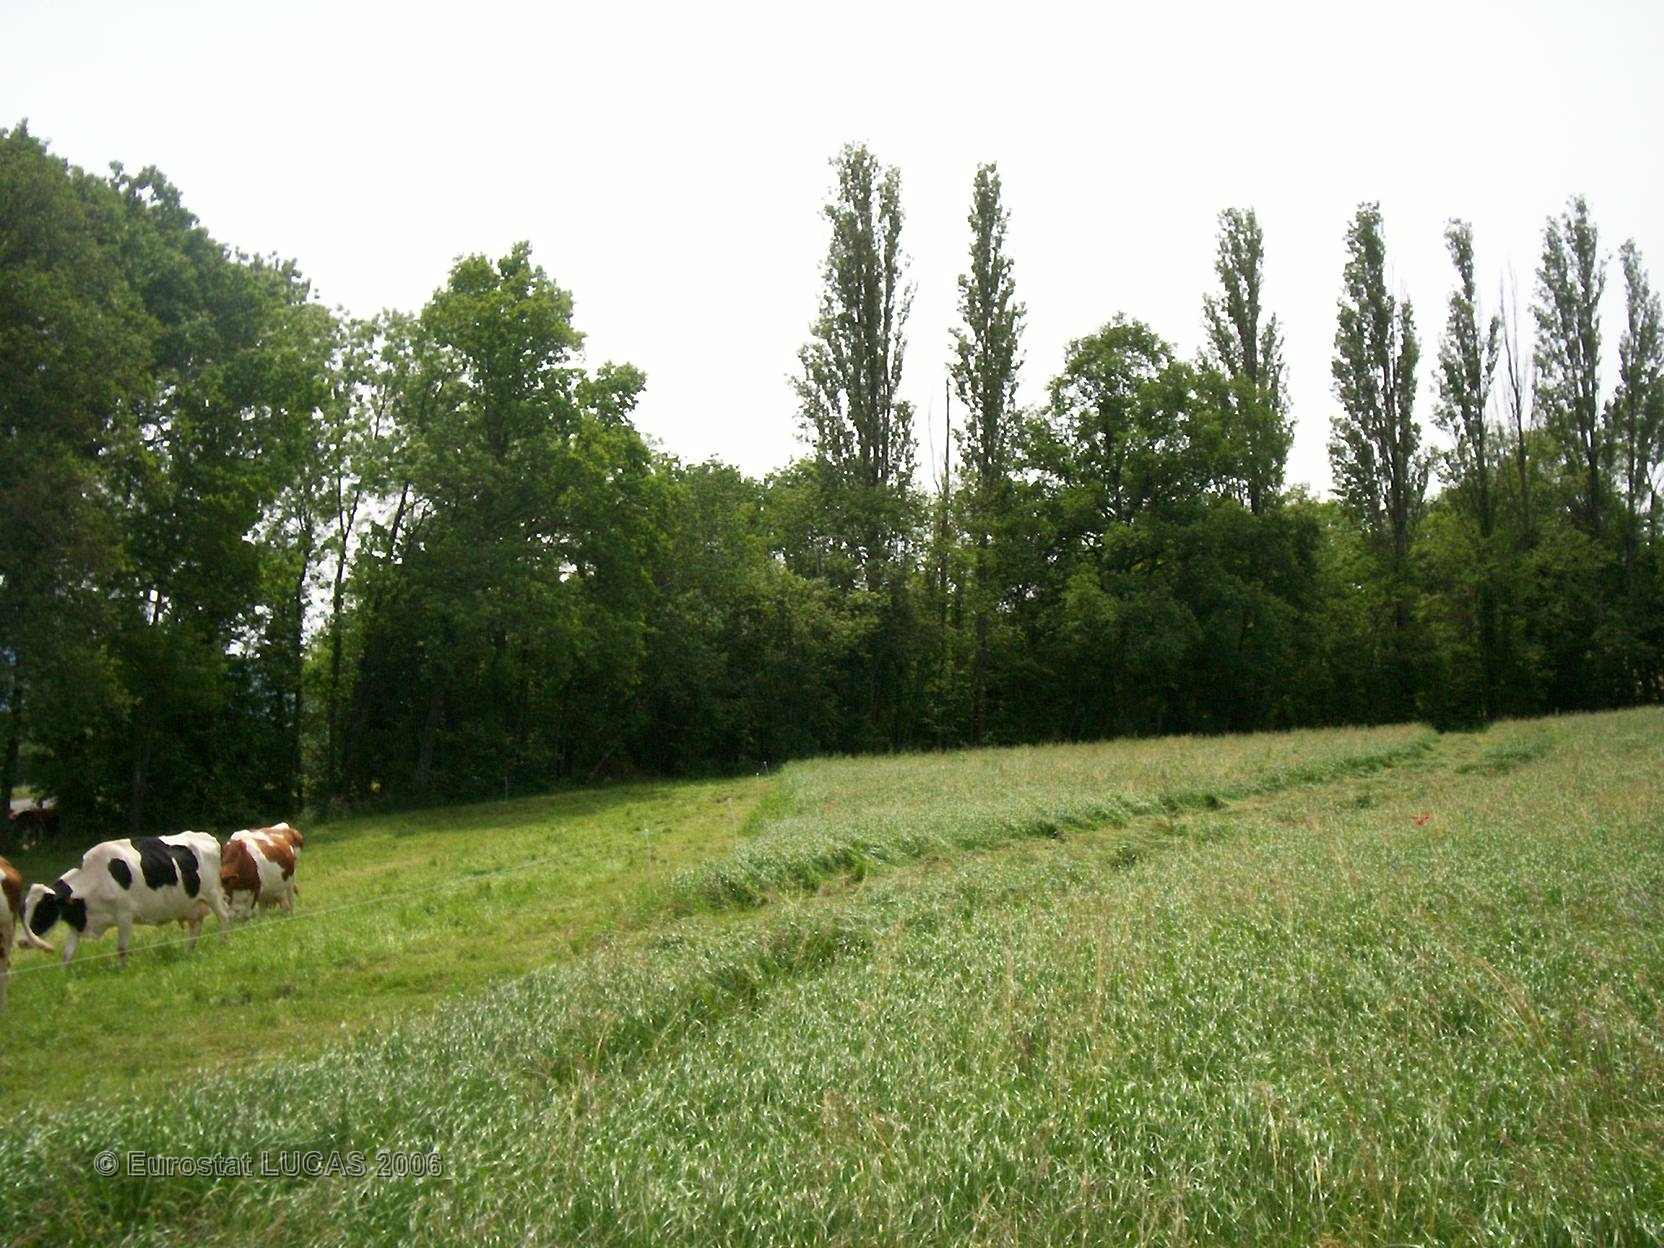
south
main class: Grassland
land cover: Grassland without tree/shrub cover
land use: Agriculture (excluding fallow land and kitchen gardens)
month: June
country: FR
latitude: 46.3080
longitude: 6.3806
